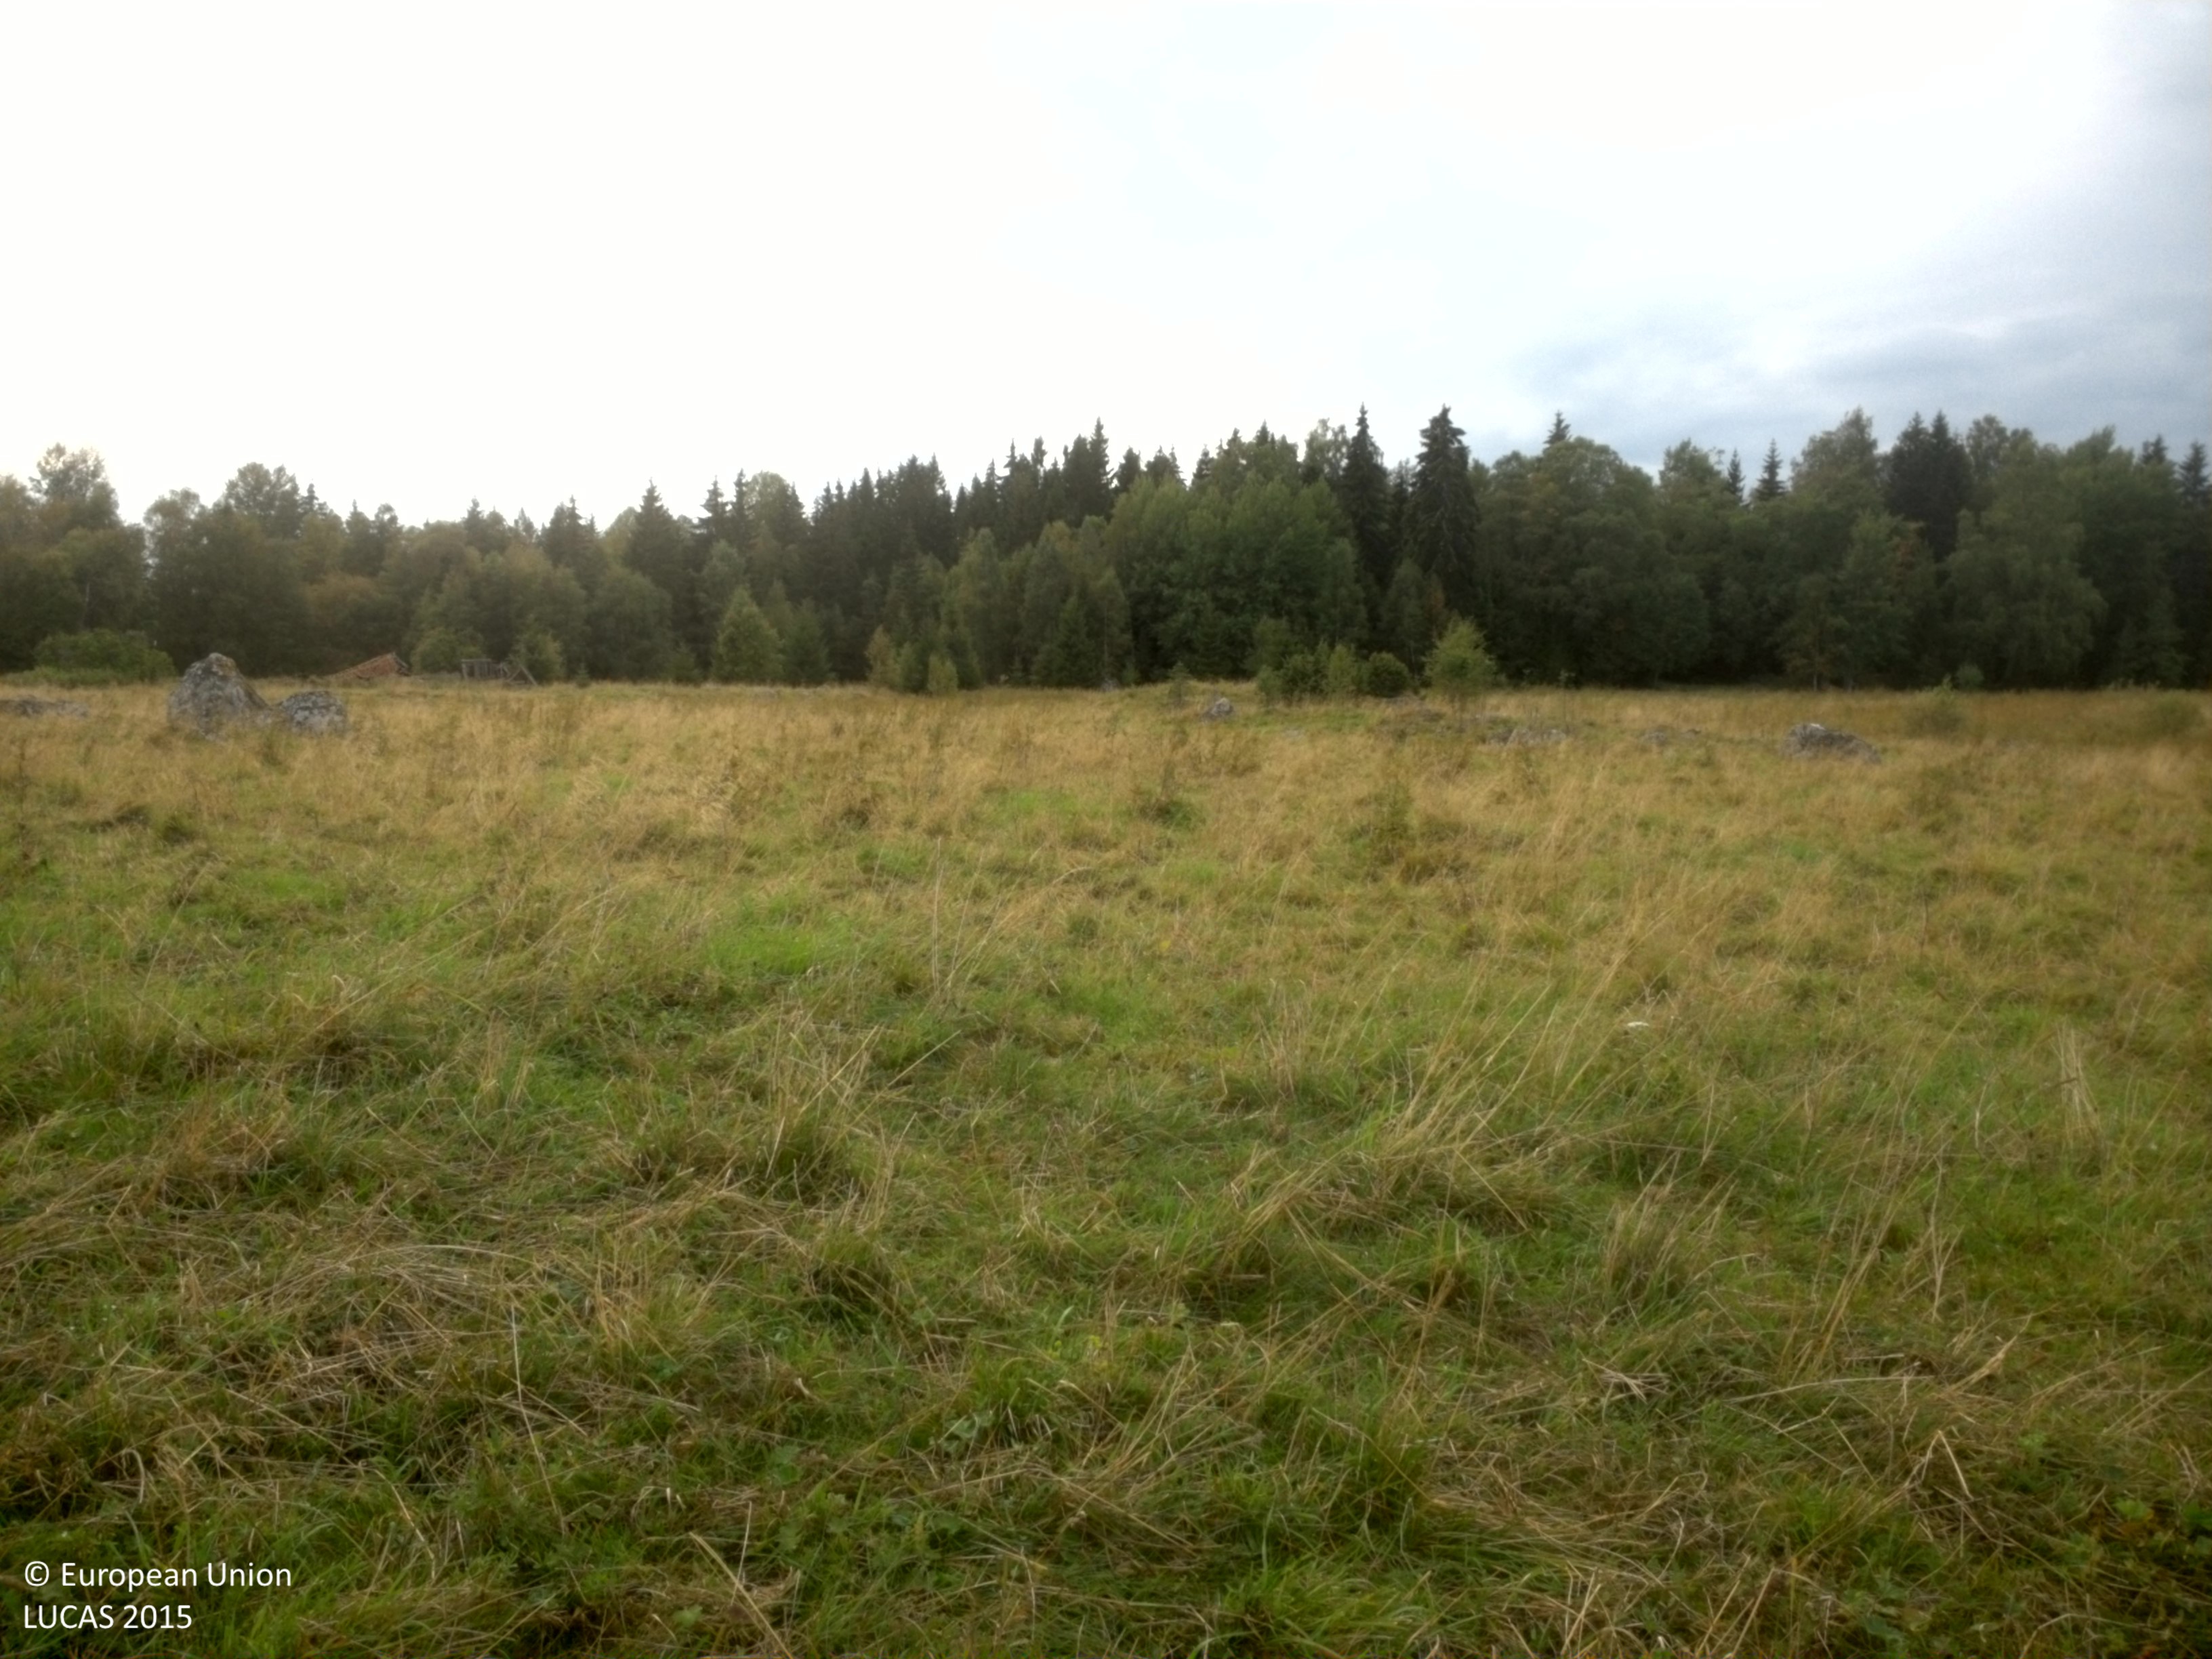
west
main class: Grassland
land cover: Grassland with sparse tree/shrub cover
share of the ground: > 75 %
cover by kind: herbaceous plants 90 %, broadleaved forest trees 5 %, shrubs 5 %
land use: Agriculture (excluding fallow land and kitchen gardens)
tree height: > 5 m
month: August
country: SE
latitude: 59.7047
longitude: 15.6954
